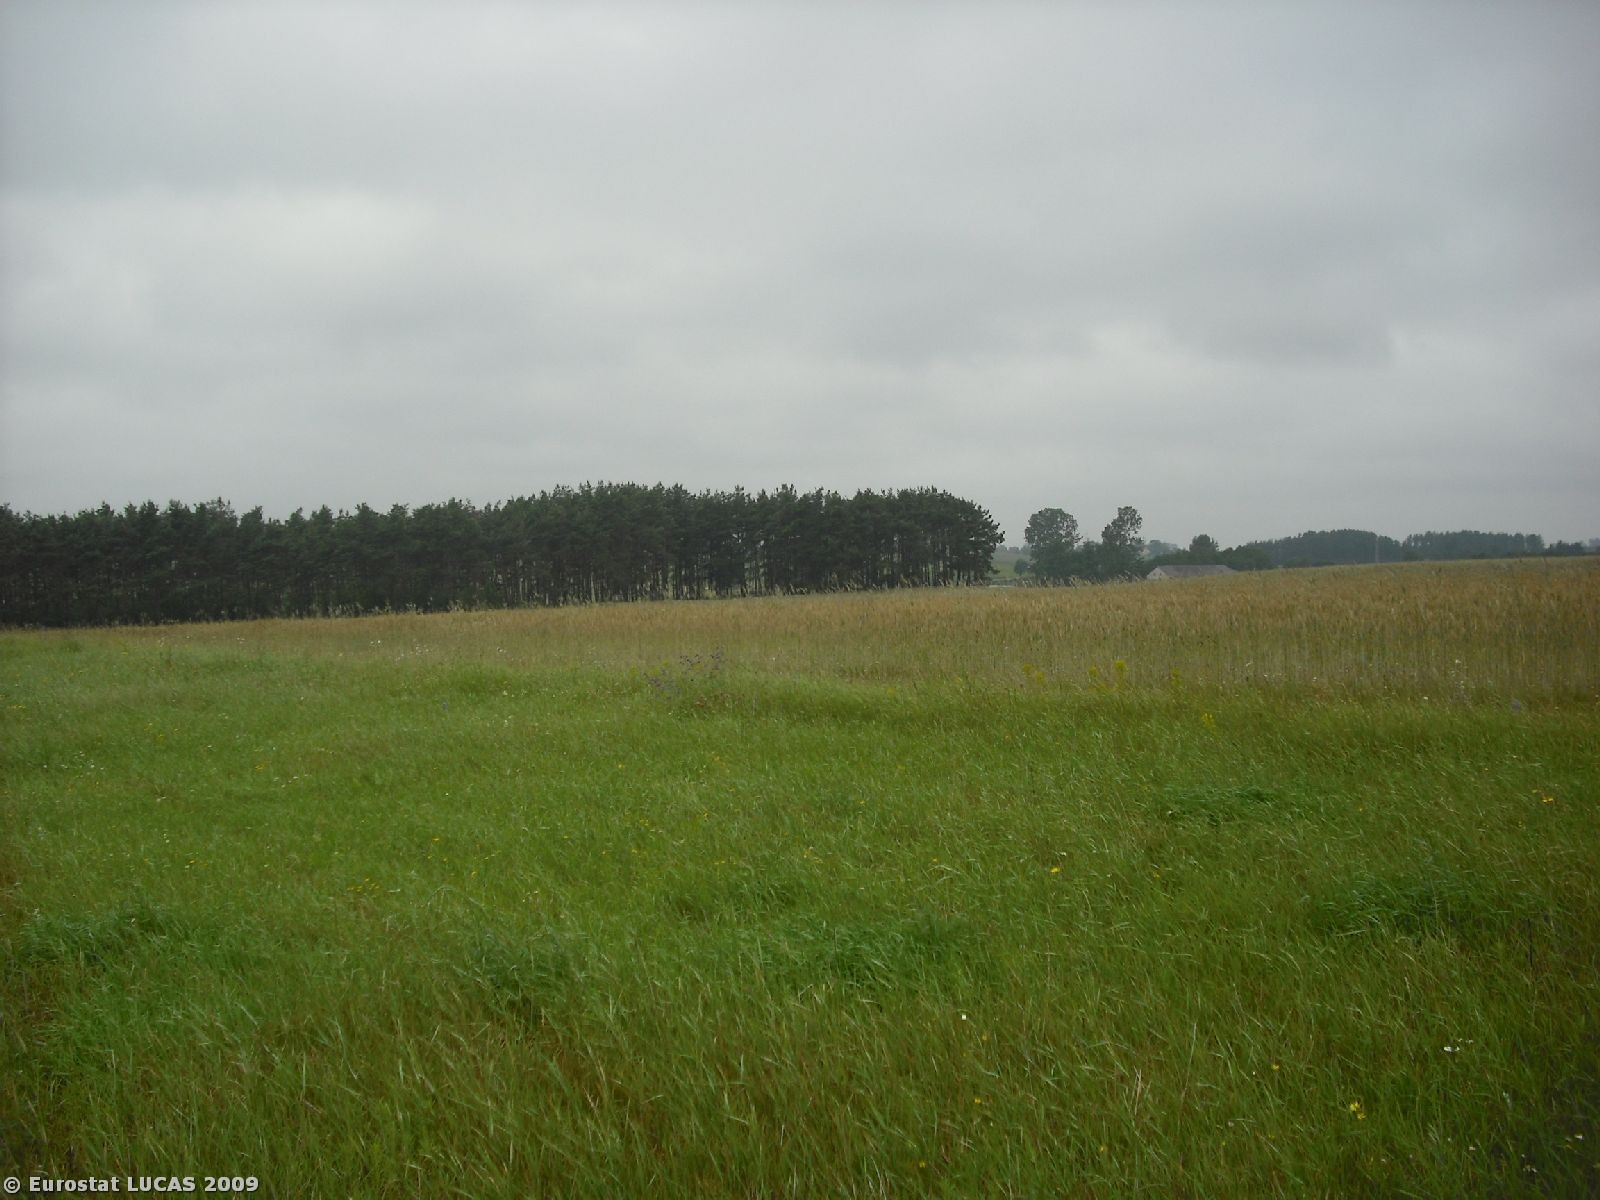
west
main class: Grassland
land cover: Grassland without tree/shrub cover
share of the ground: > 75 %
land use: Agriculture (excluding fallow land and kitchen gardens)
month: June
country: PL
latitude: 54.1379
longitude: 22.8201
